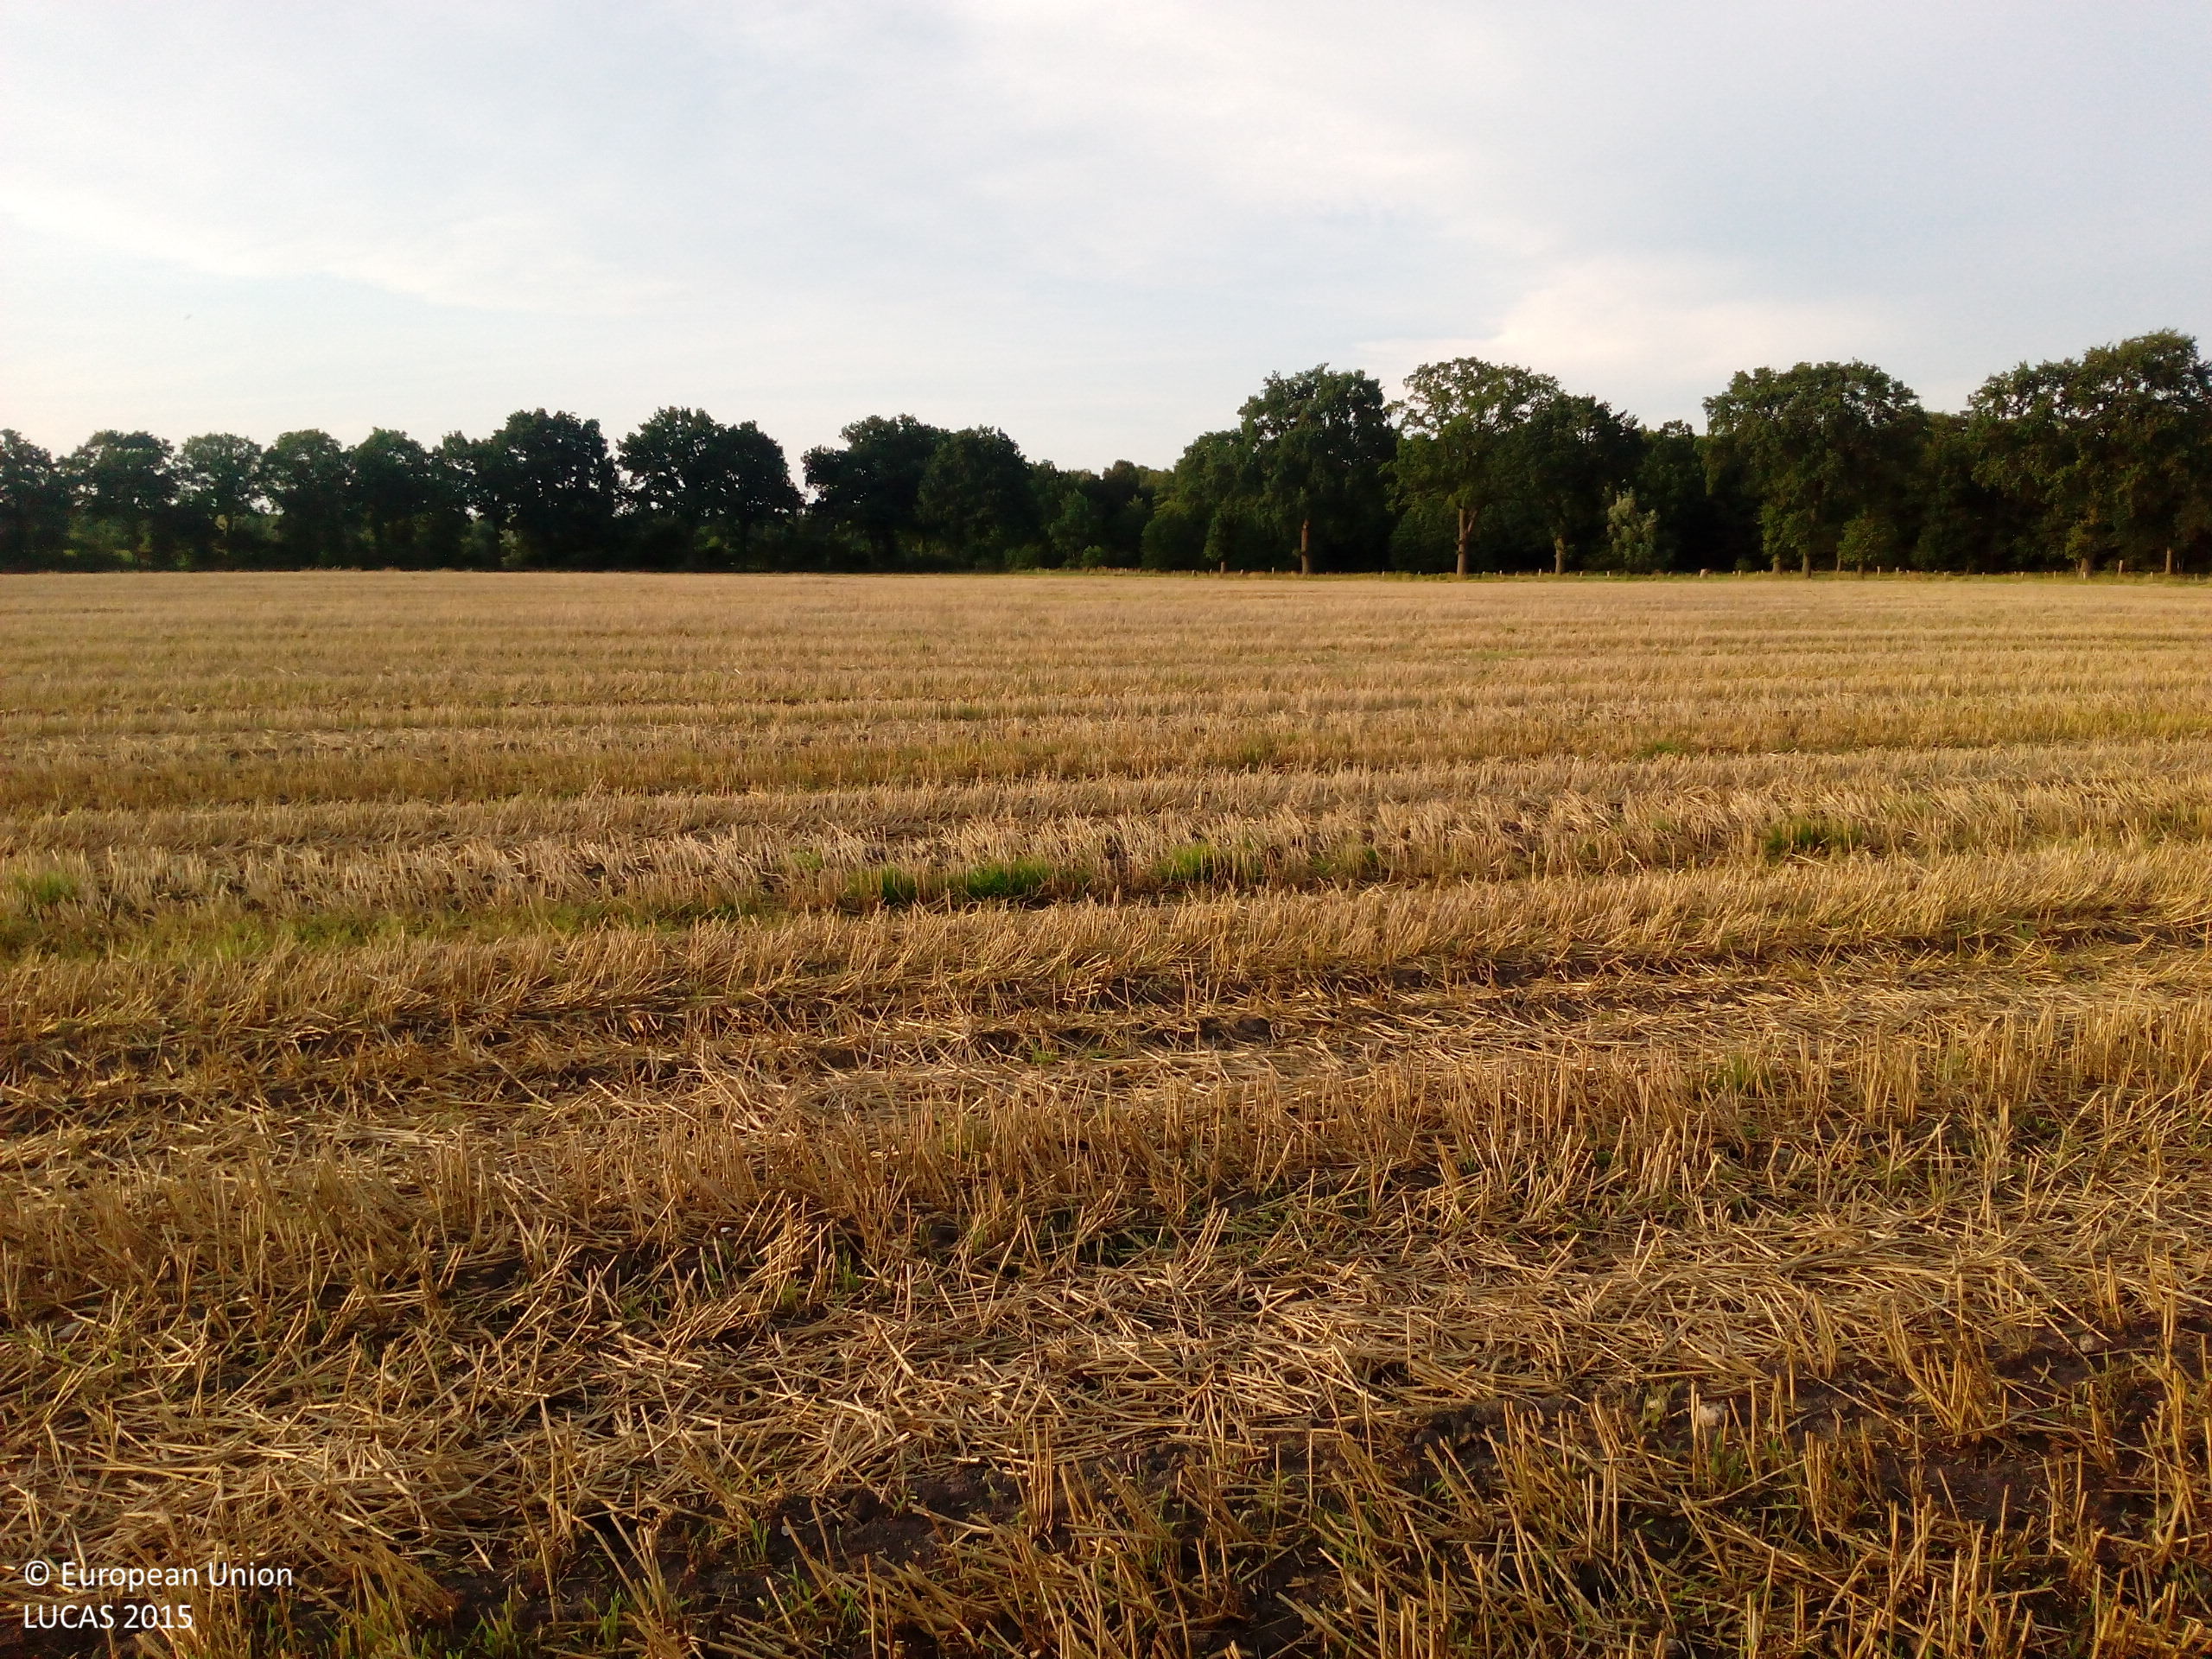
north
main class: Cropland
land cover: Rye
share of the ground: 50 - 75 %
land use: Agriculture (excluding fallow land and kitchen gardens)
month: August
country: DE
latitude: 53.7074
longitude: 9.9243
